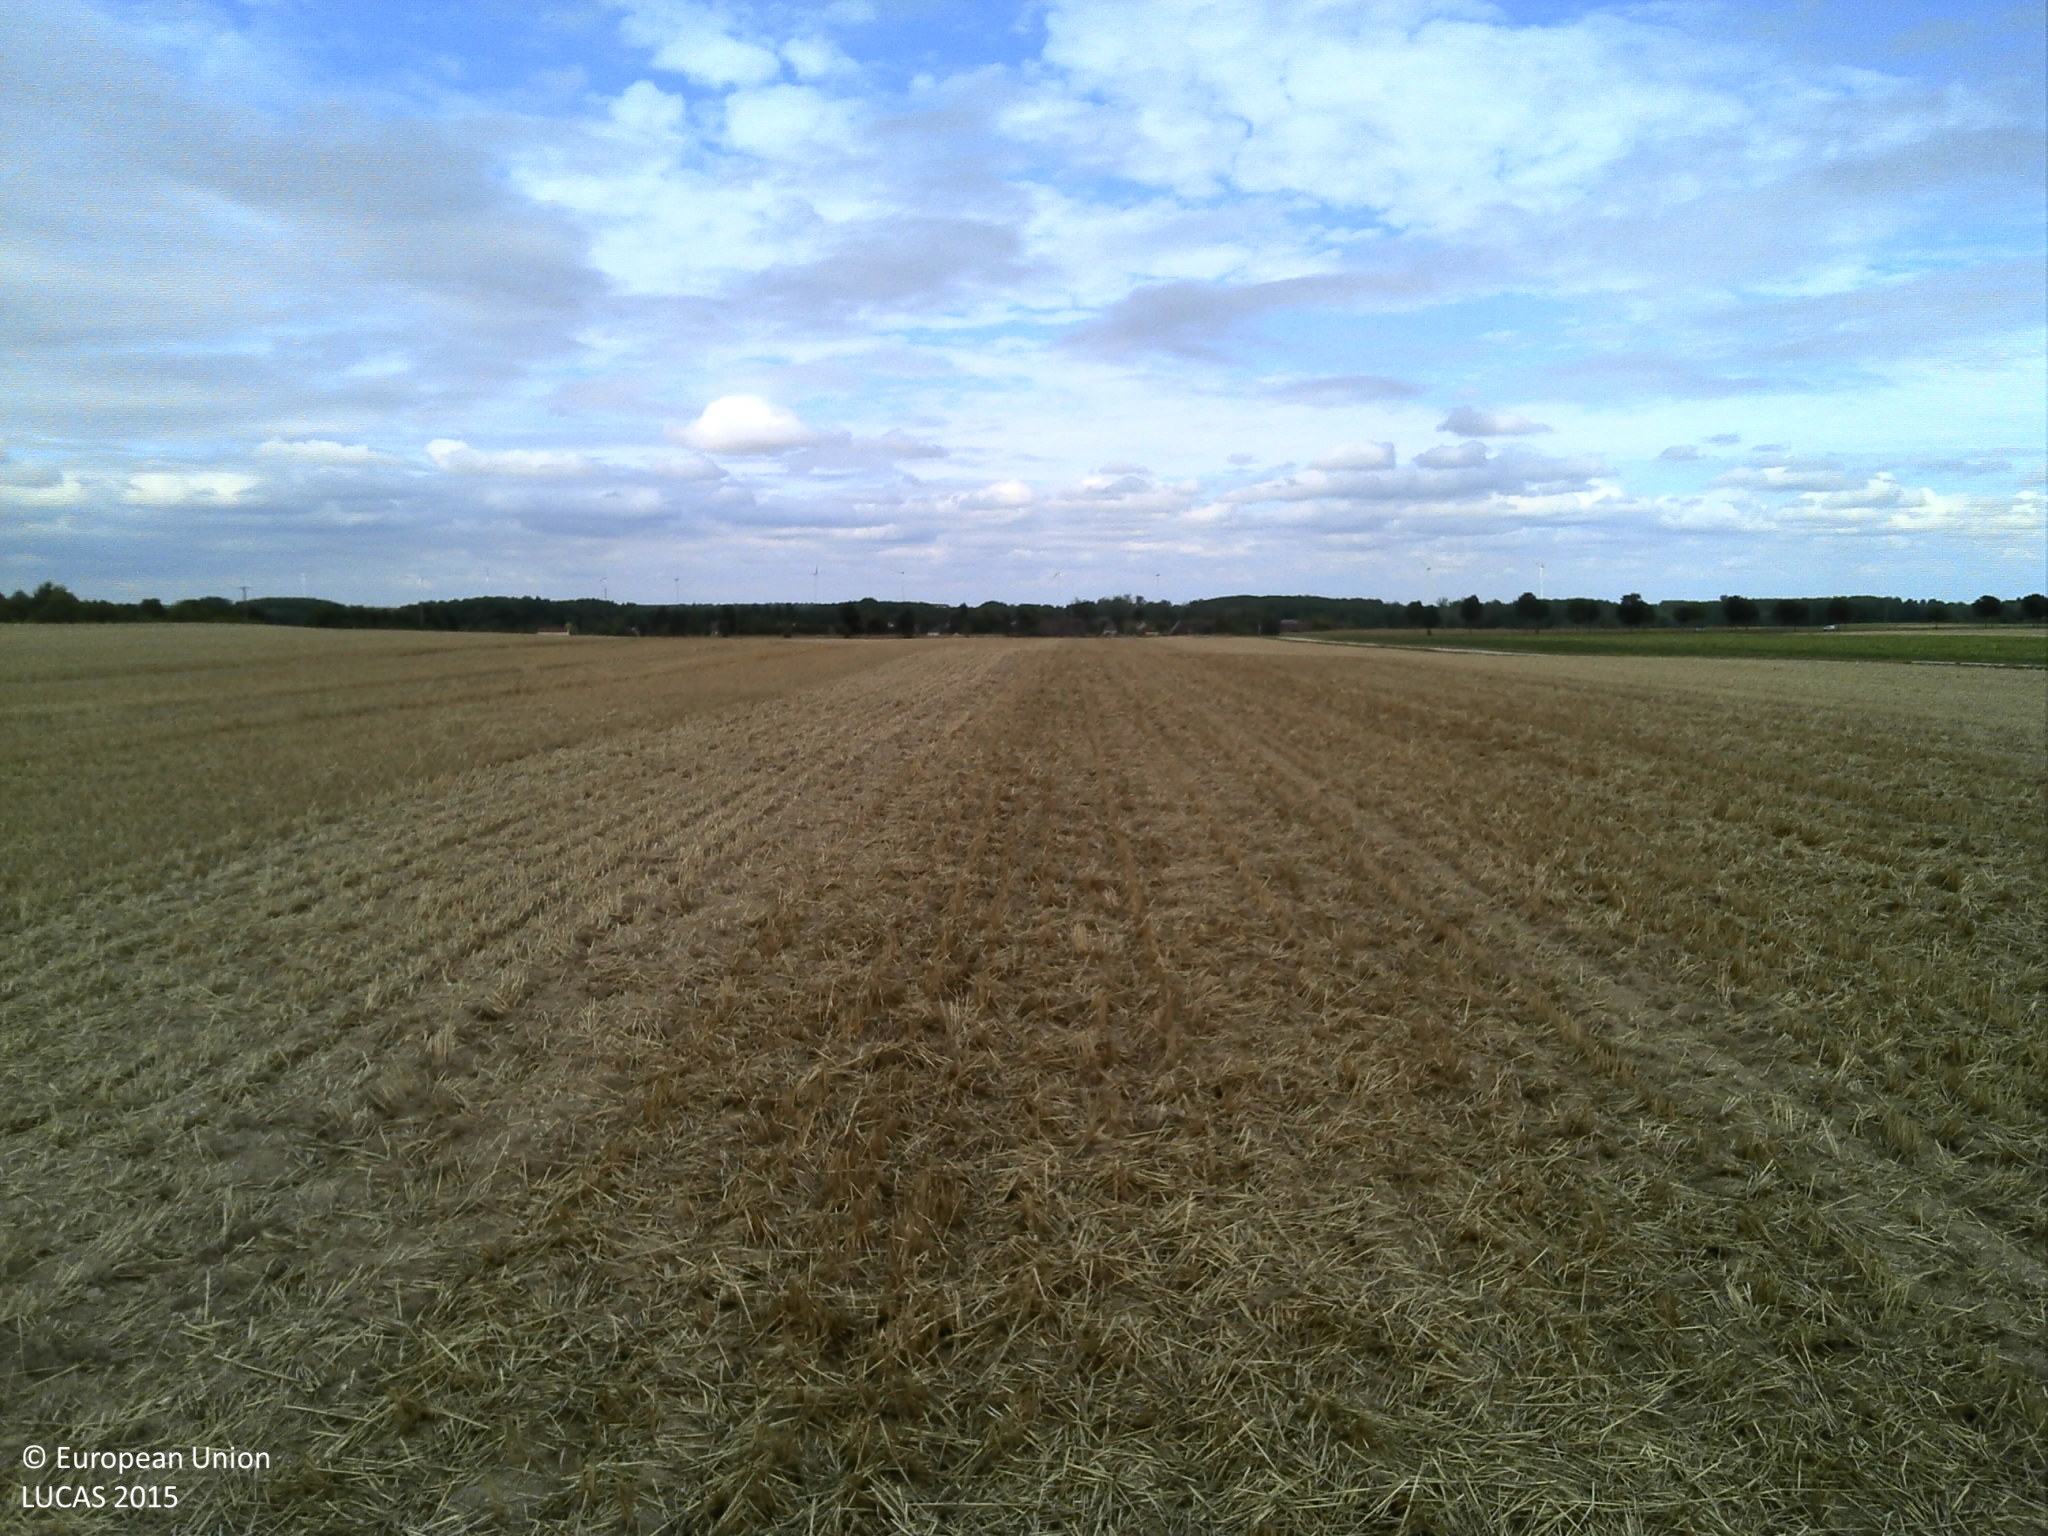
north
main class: Cropland
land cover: Common wheat
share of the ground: > 75 %
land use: Agriculture (excluding fallow land and kitchen gardens)
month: August
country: FR
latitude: 48.5212
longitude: 4.1879
